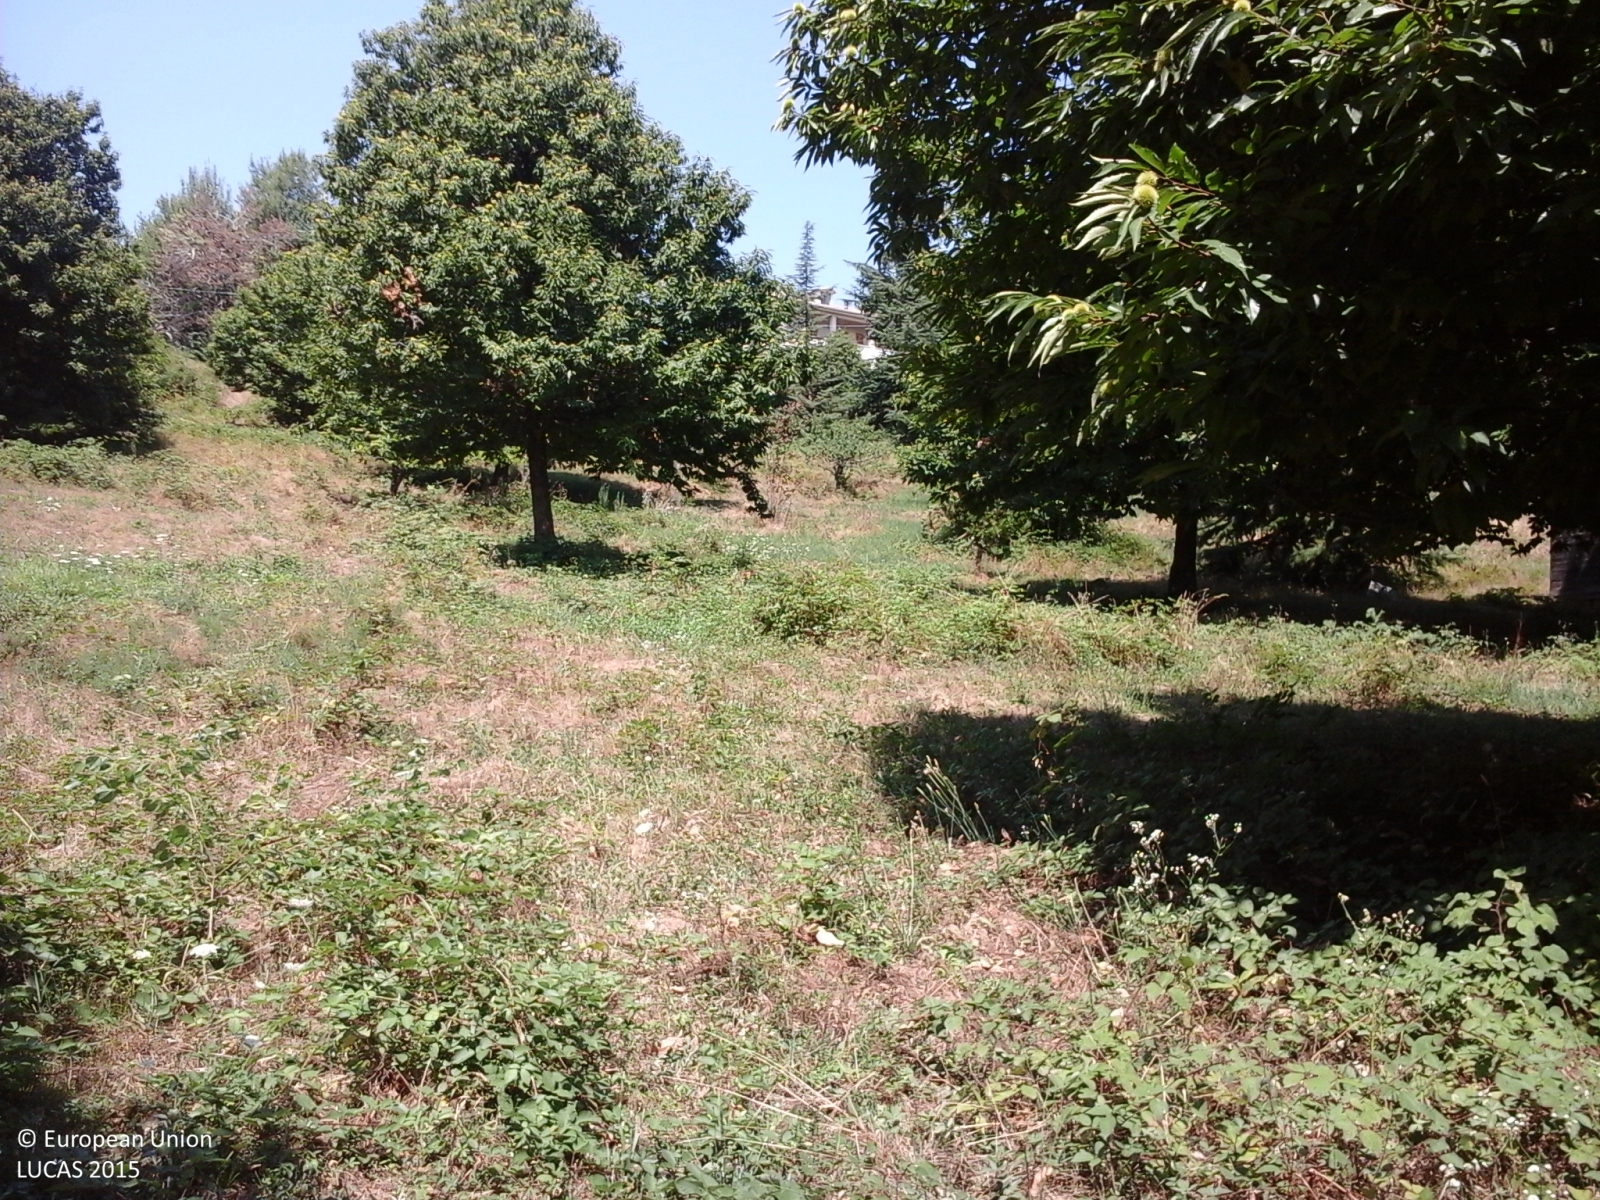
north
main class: Woodland
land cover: Broadleaved woodland
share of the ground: > 75 %
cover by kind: broadleaved forest trees 70 %, herbaceous plants 30 %
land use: Agriculture (excluding fallow land and kitchen gardens)
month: August
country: IT
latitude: 44.3275
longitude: 7.8103
